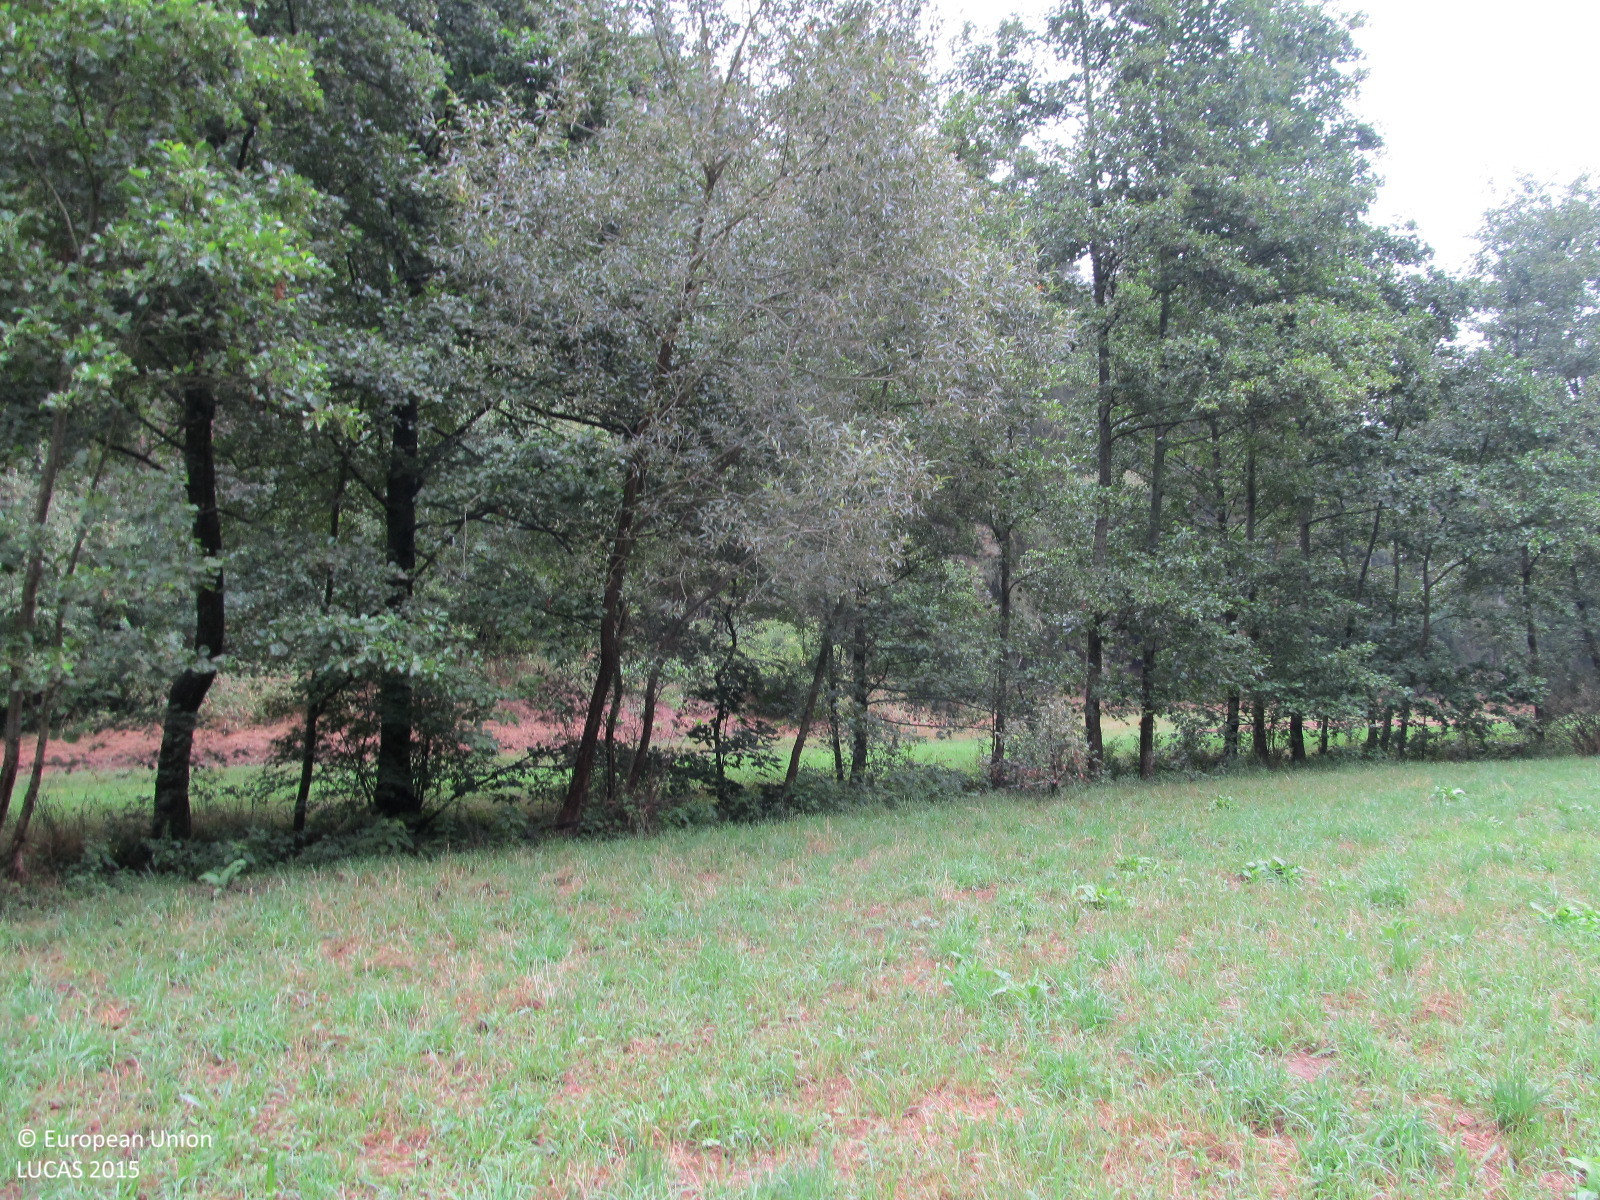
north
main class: Grassland
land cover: Grassland without tree/shrub cover
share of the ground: > 75 %
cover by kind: herbaceous plants 100 %
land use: Agriculture (excluding fallow land and kitchen gardens)
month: August
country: AT
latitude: 48.8094
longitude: 15.4634
